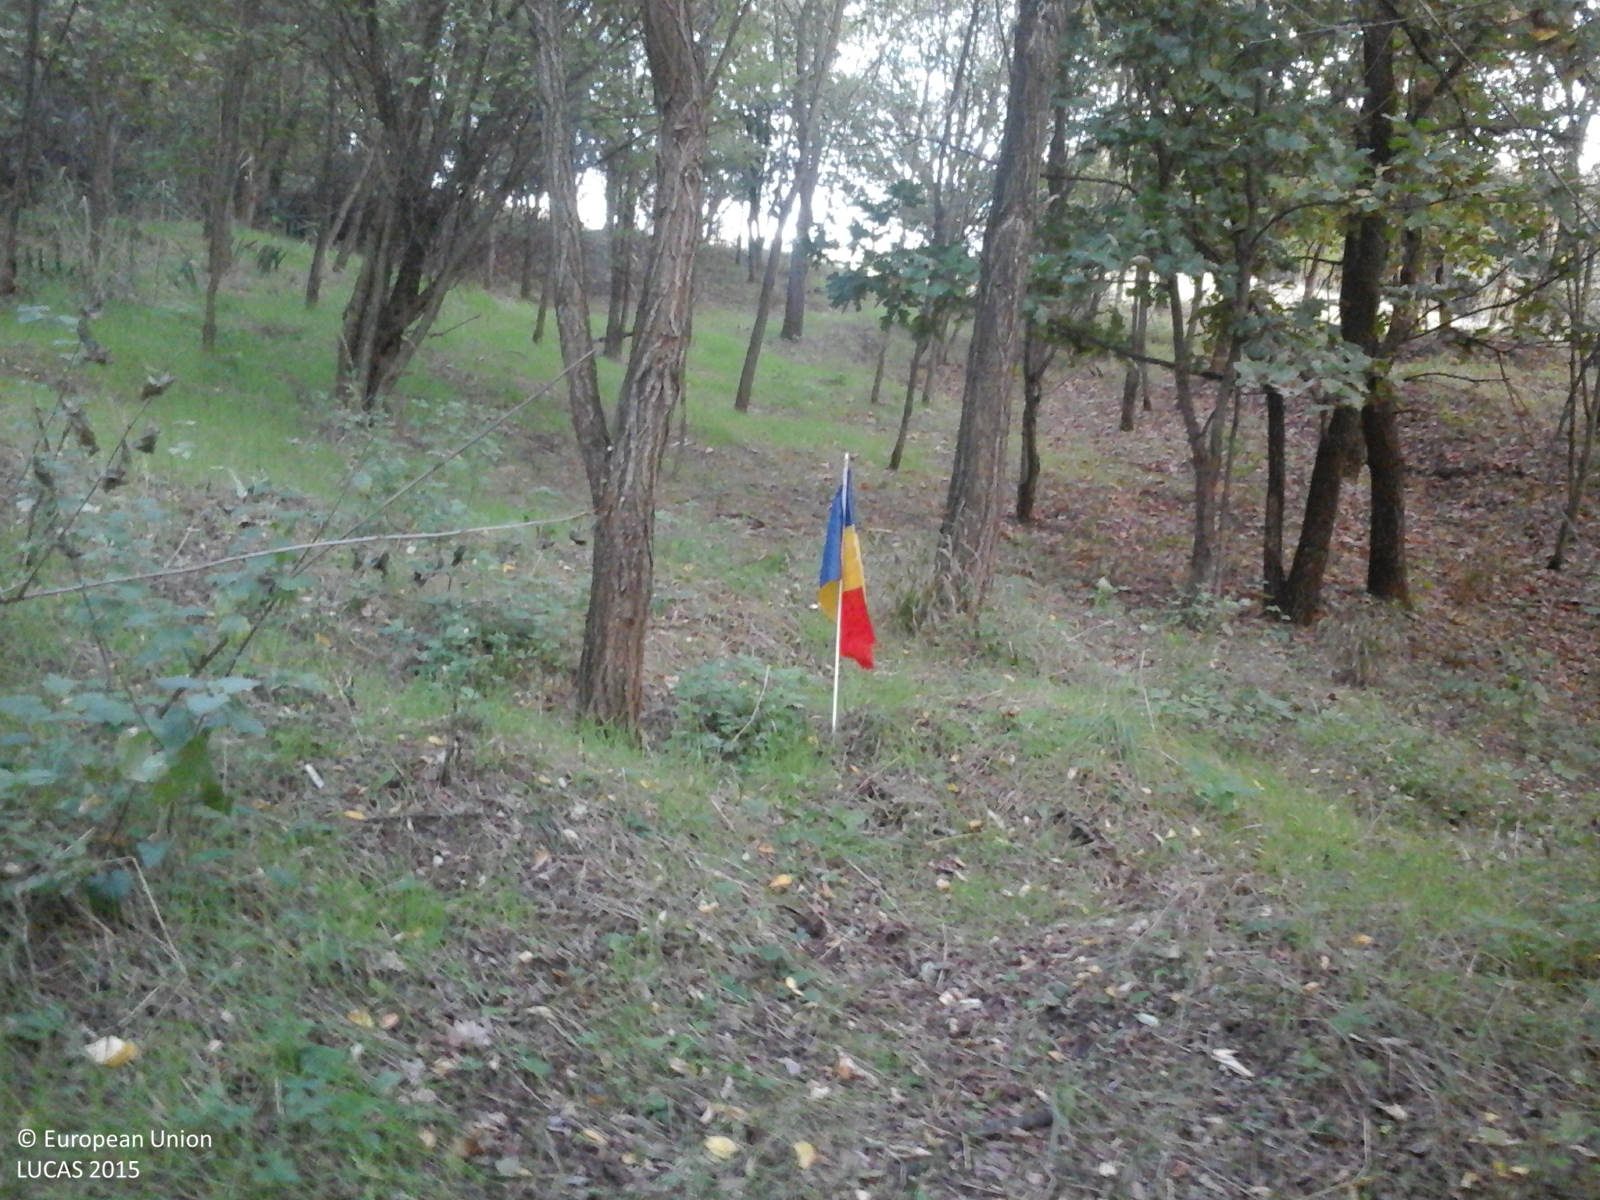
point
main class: Woodland
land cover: Broadleaved woodland
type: exotic forest
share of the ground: > 75 %
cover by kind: broadleaved forest trees 100 %
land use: Forestry
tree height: > 5 m
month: October
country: RO
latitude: 46.5304
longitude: 24.0676
